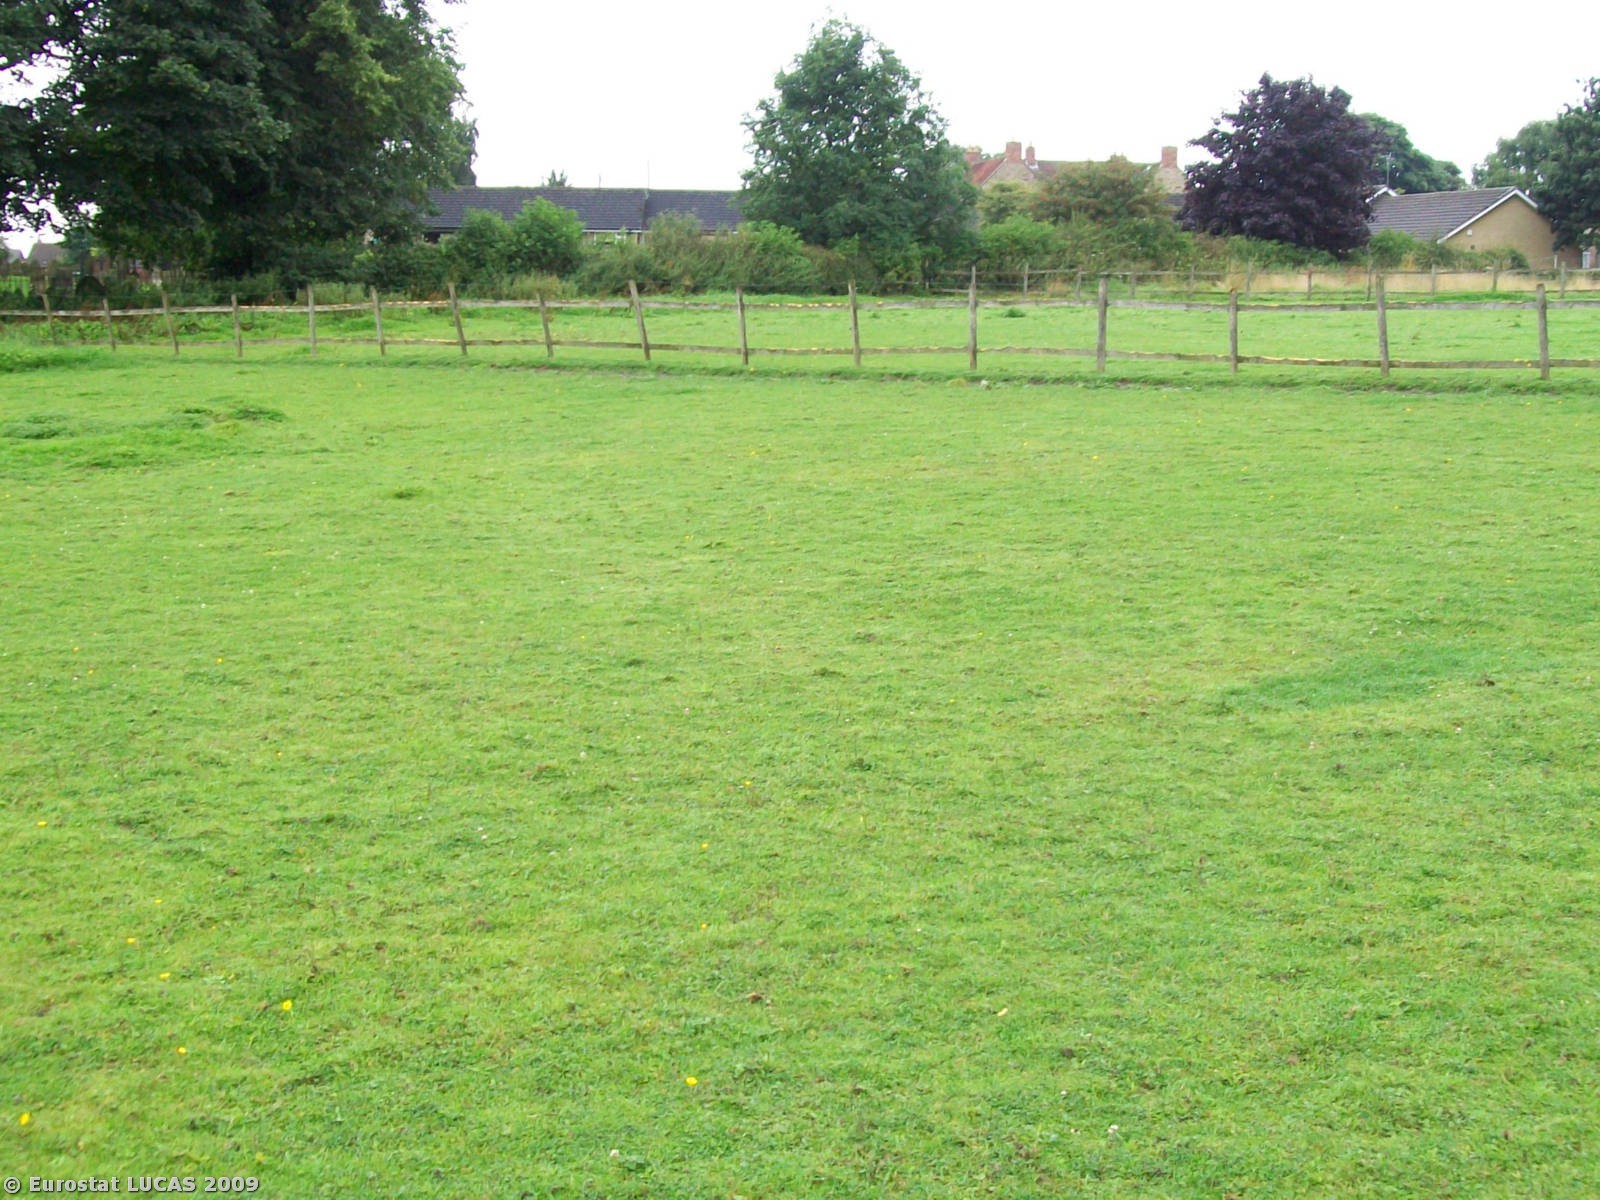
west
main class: Grassland
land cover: Grassland without tree/shrub cover
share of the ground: > 75 %
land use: Agriculture (excluding fallow land and kitchen gardens)
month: August
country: GB
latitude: 53.2904
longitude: -1.2834
